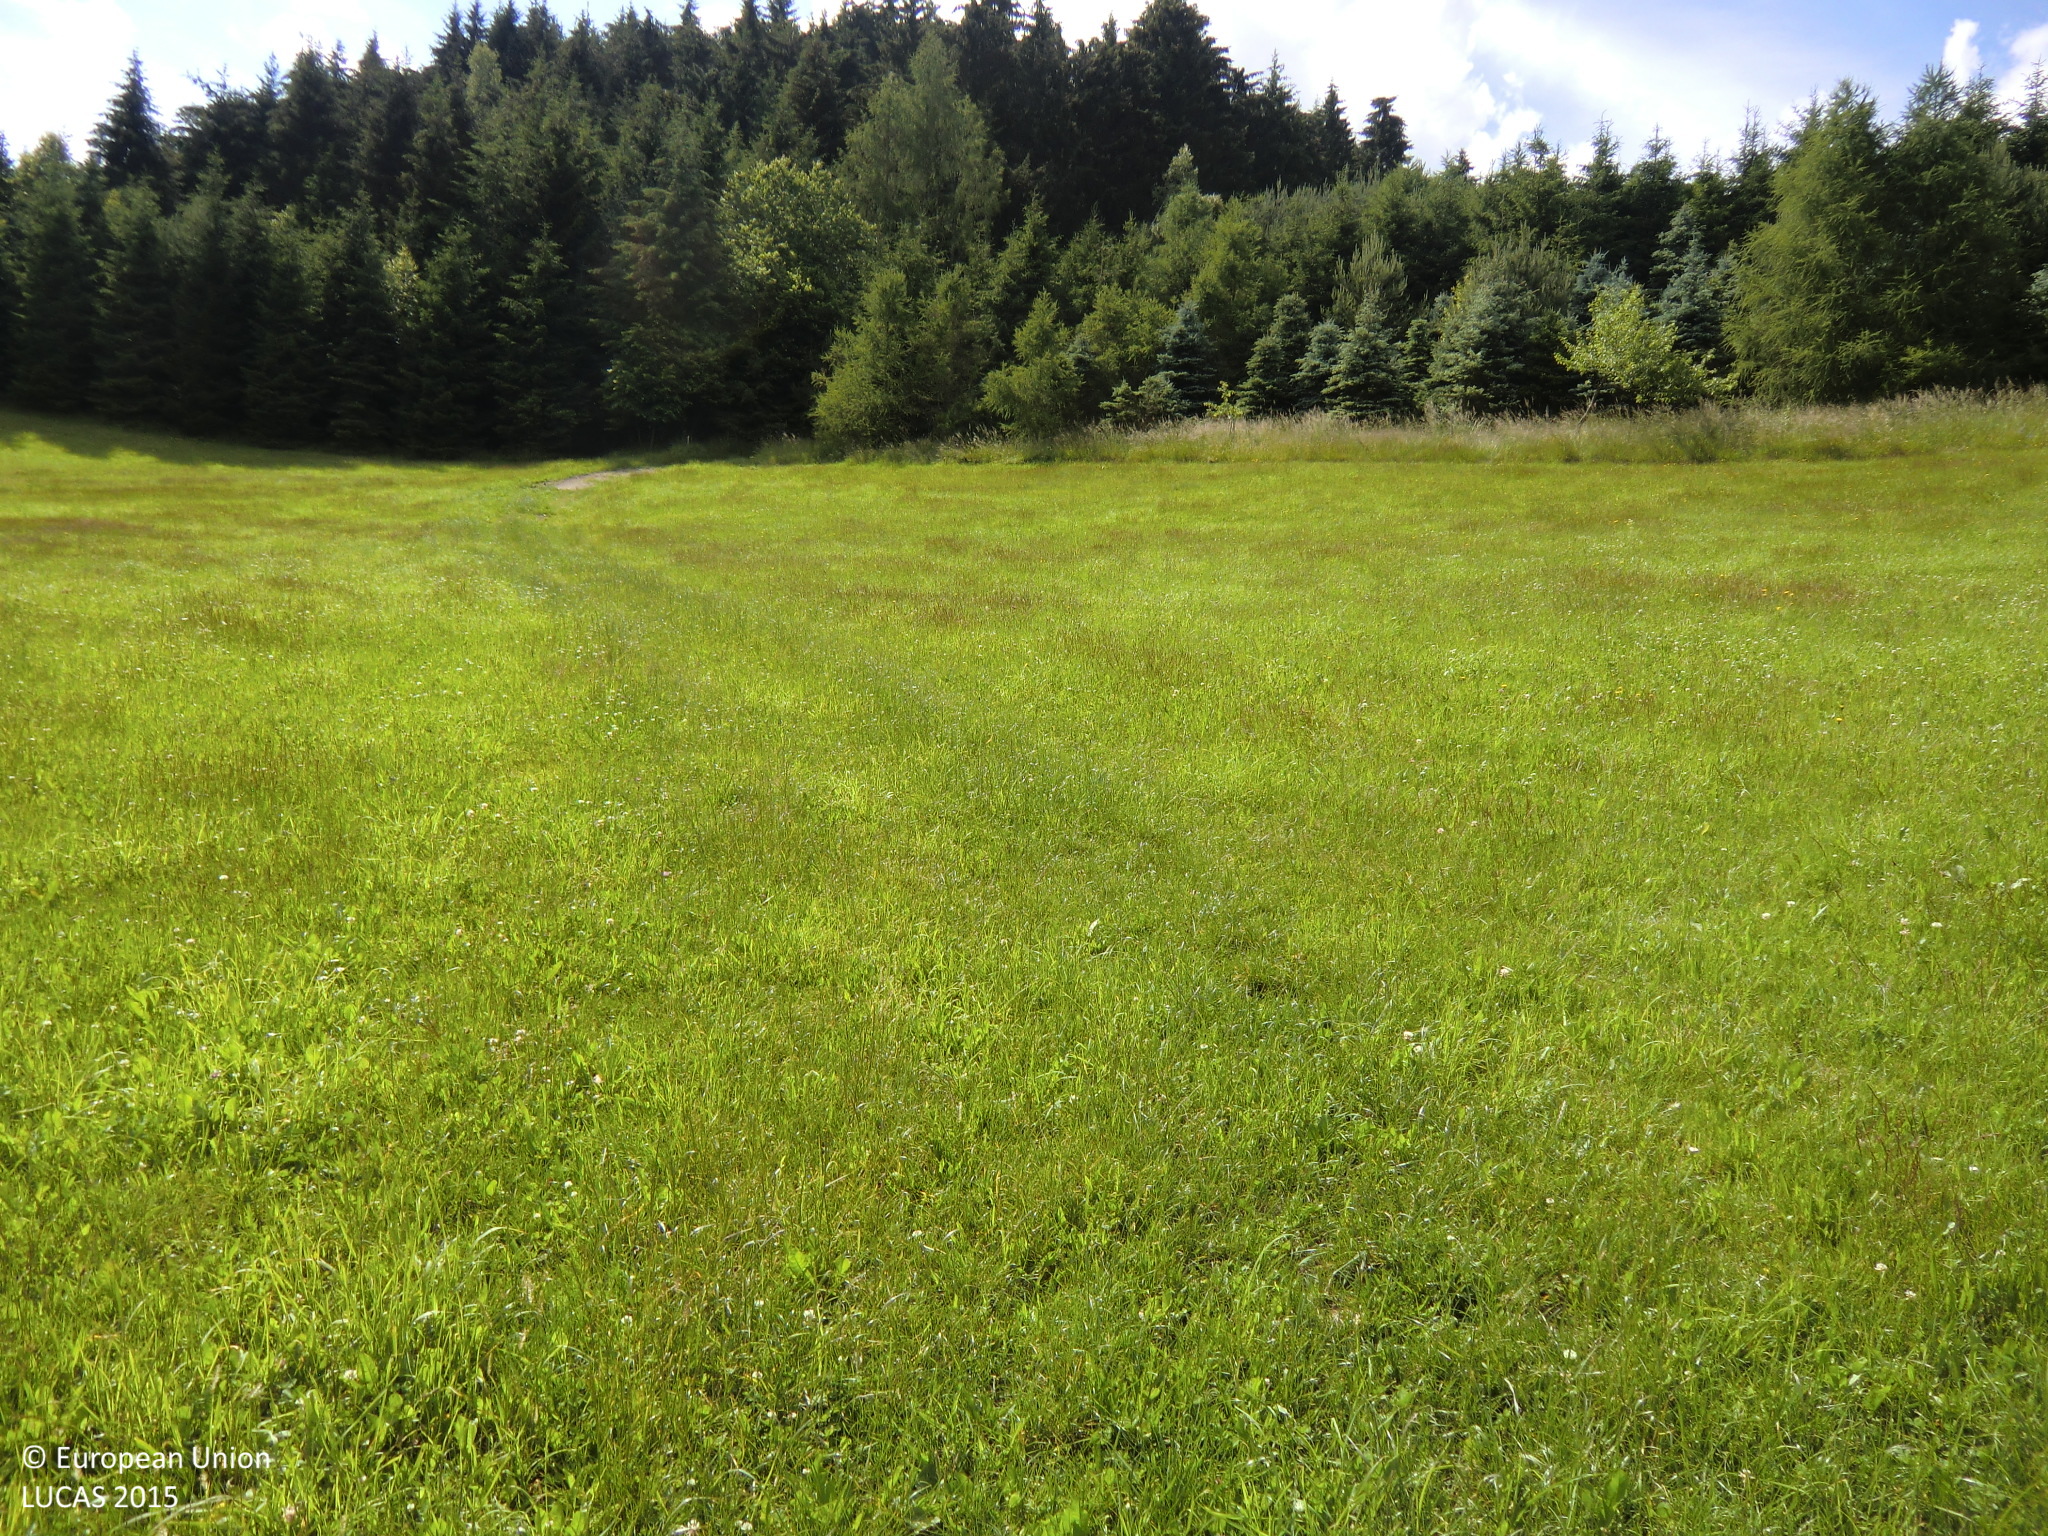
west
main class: Grassland
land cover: Grassland without tree/shrub cover
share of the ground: > 75 %
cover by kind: herbaceous plants 95 %, unconsolidated bare surface 5 %
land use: Agriculture (excluding fallow land and kitchen gardens)
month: June
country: AT
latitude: 48.5668
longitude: 14.8664
